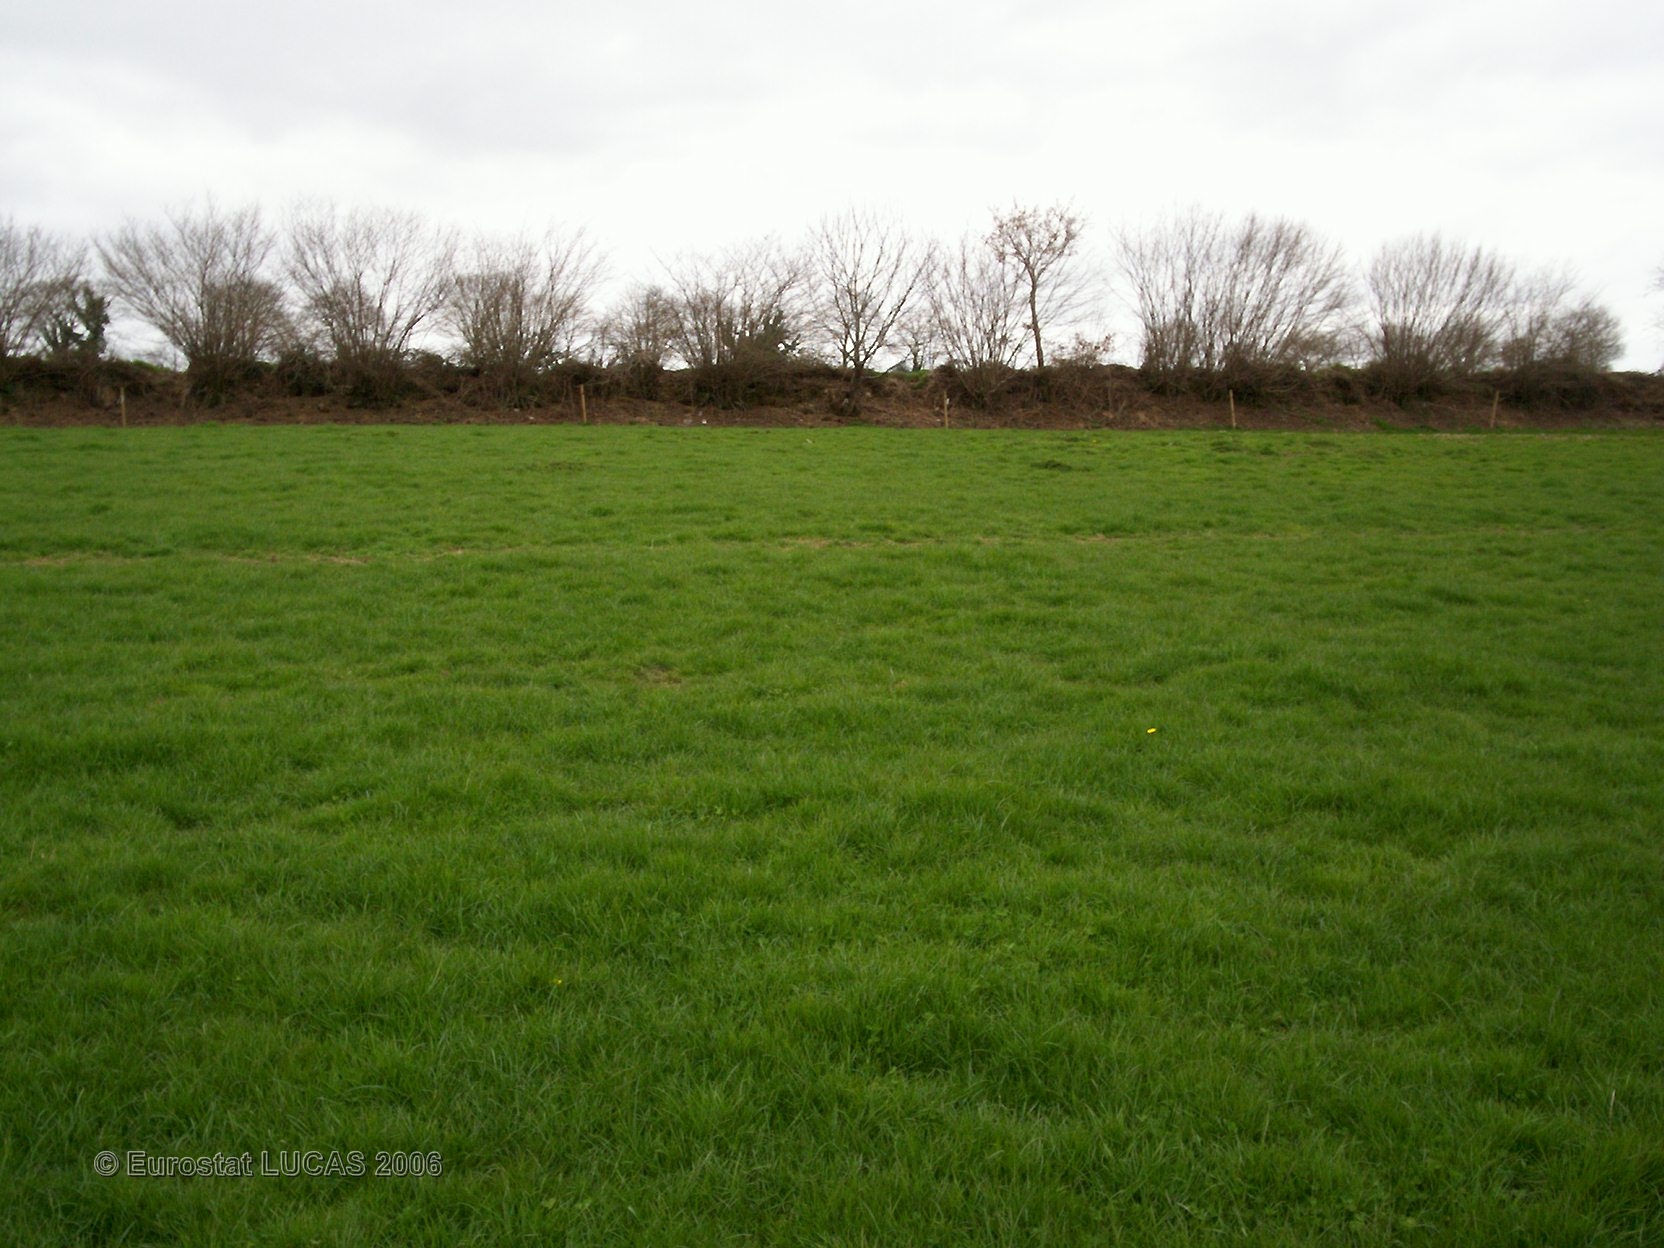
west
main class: Grassland
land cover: Grassland without tree/shrub cover
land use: Agriculture (excluding fallow land and kitchen gardens)
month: April
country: FR
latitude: 48.1935
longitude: -3.6270
